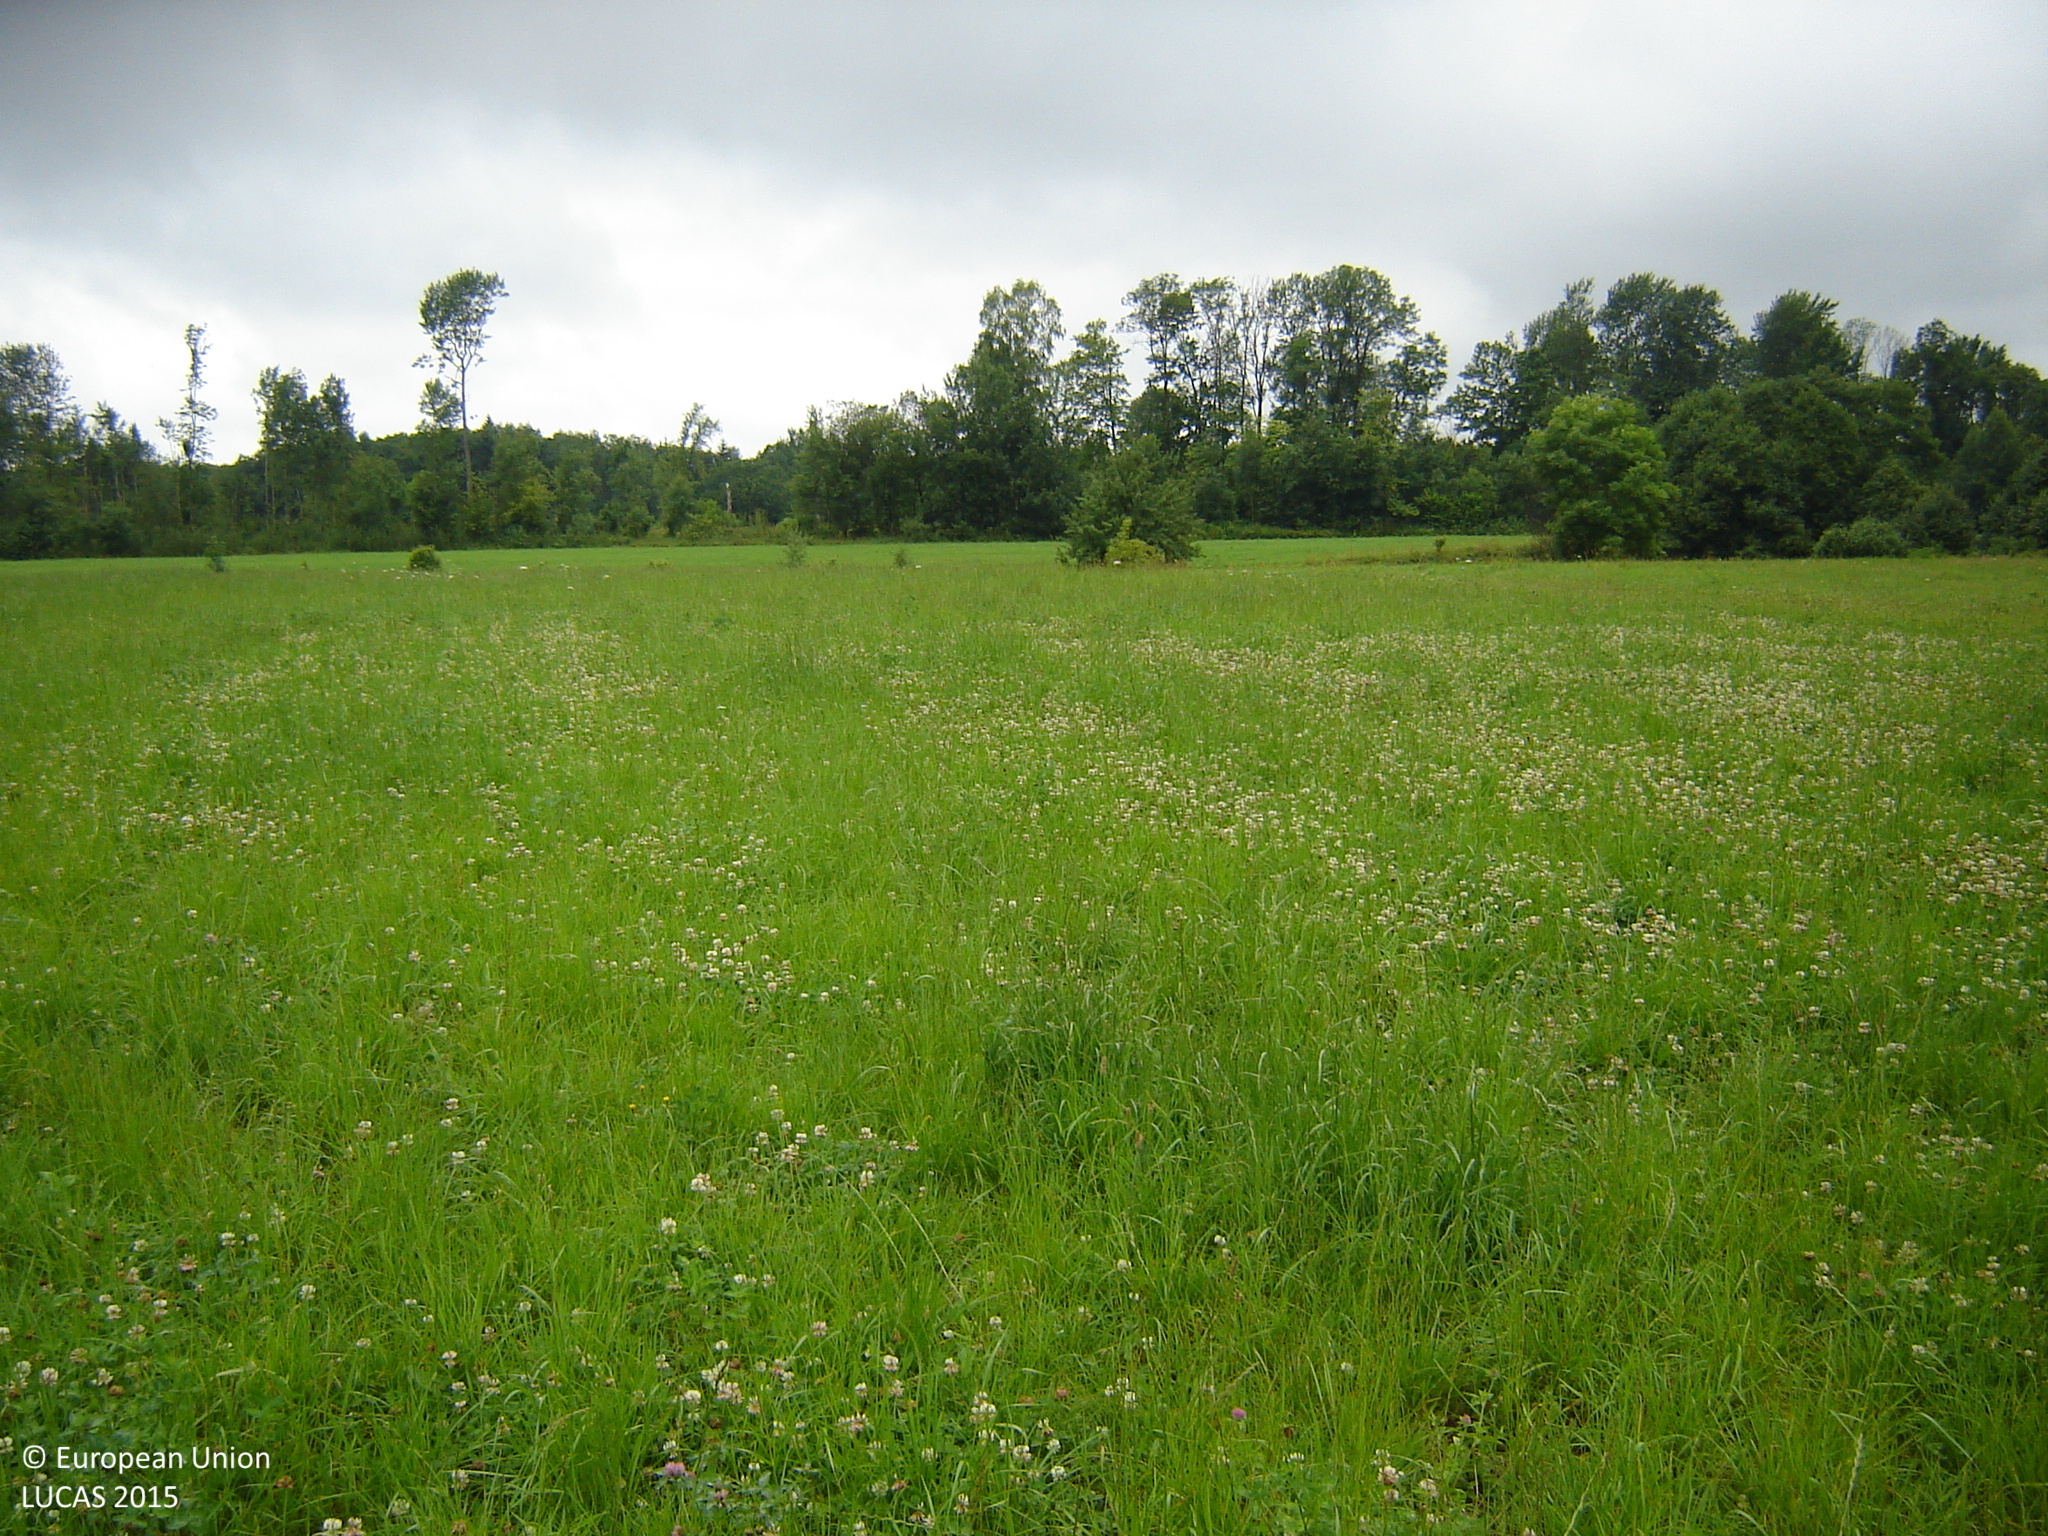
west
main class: Grassland
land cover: Grassland without tree/shrub cover
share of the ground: > 75 %
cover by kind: herbaceous plants 100 %
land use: Agriculture (excluding fallow land and kitchen gardens)
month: July
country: LT
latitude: 55.3467
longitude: 25.2088
